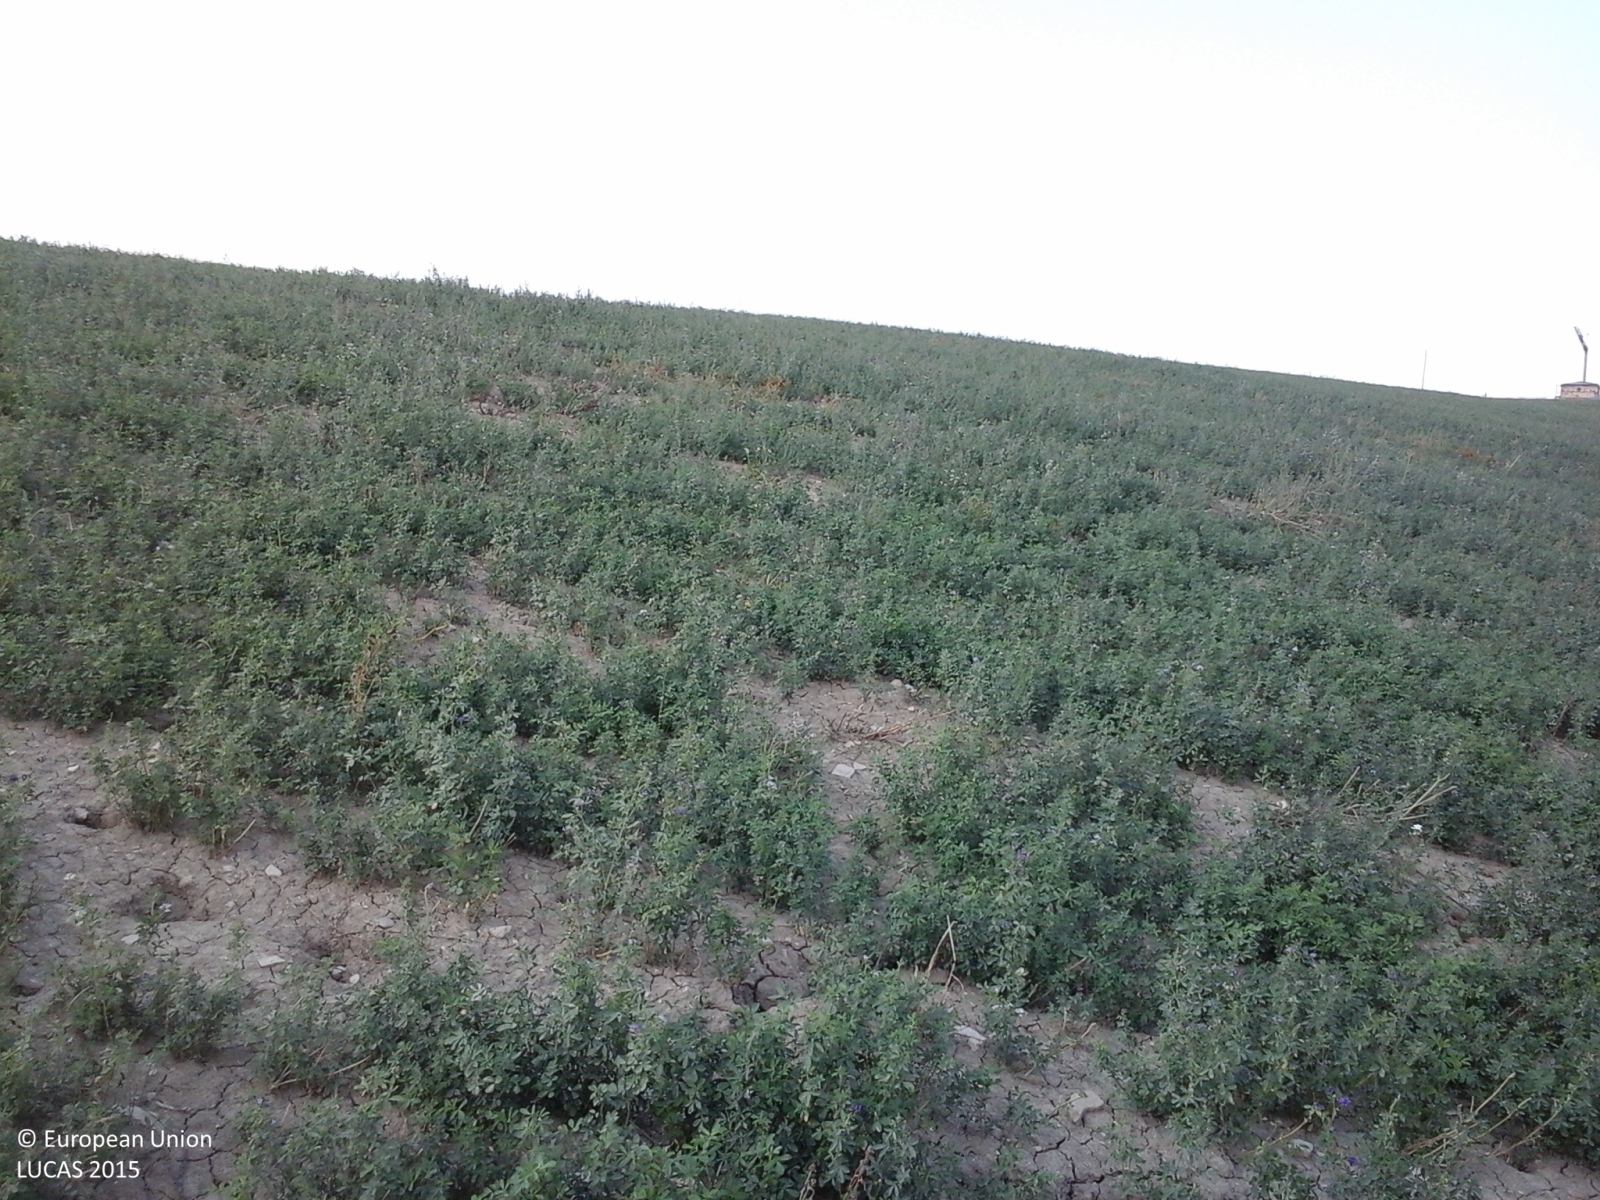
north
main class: Cropland
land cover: Lucerne
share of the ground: > 75 %
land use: Agriculture (excluding fallow land and kitchen gardens)
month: August
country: IT
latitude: 42.7098
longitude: 13.7862
